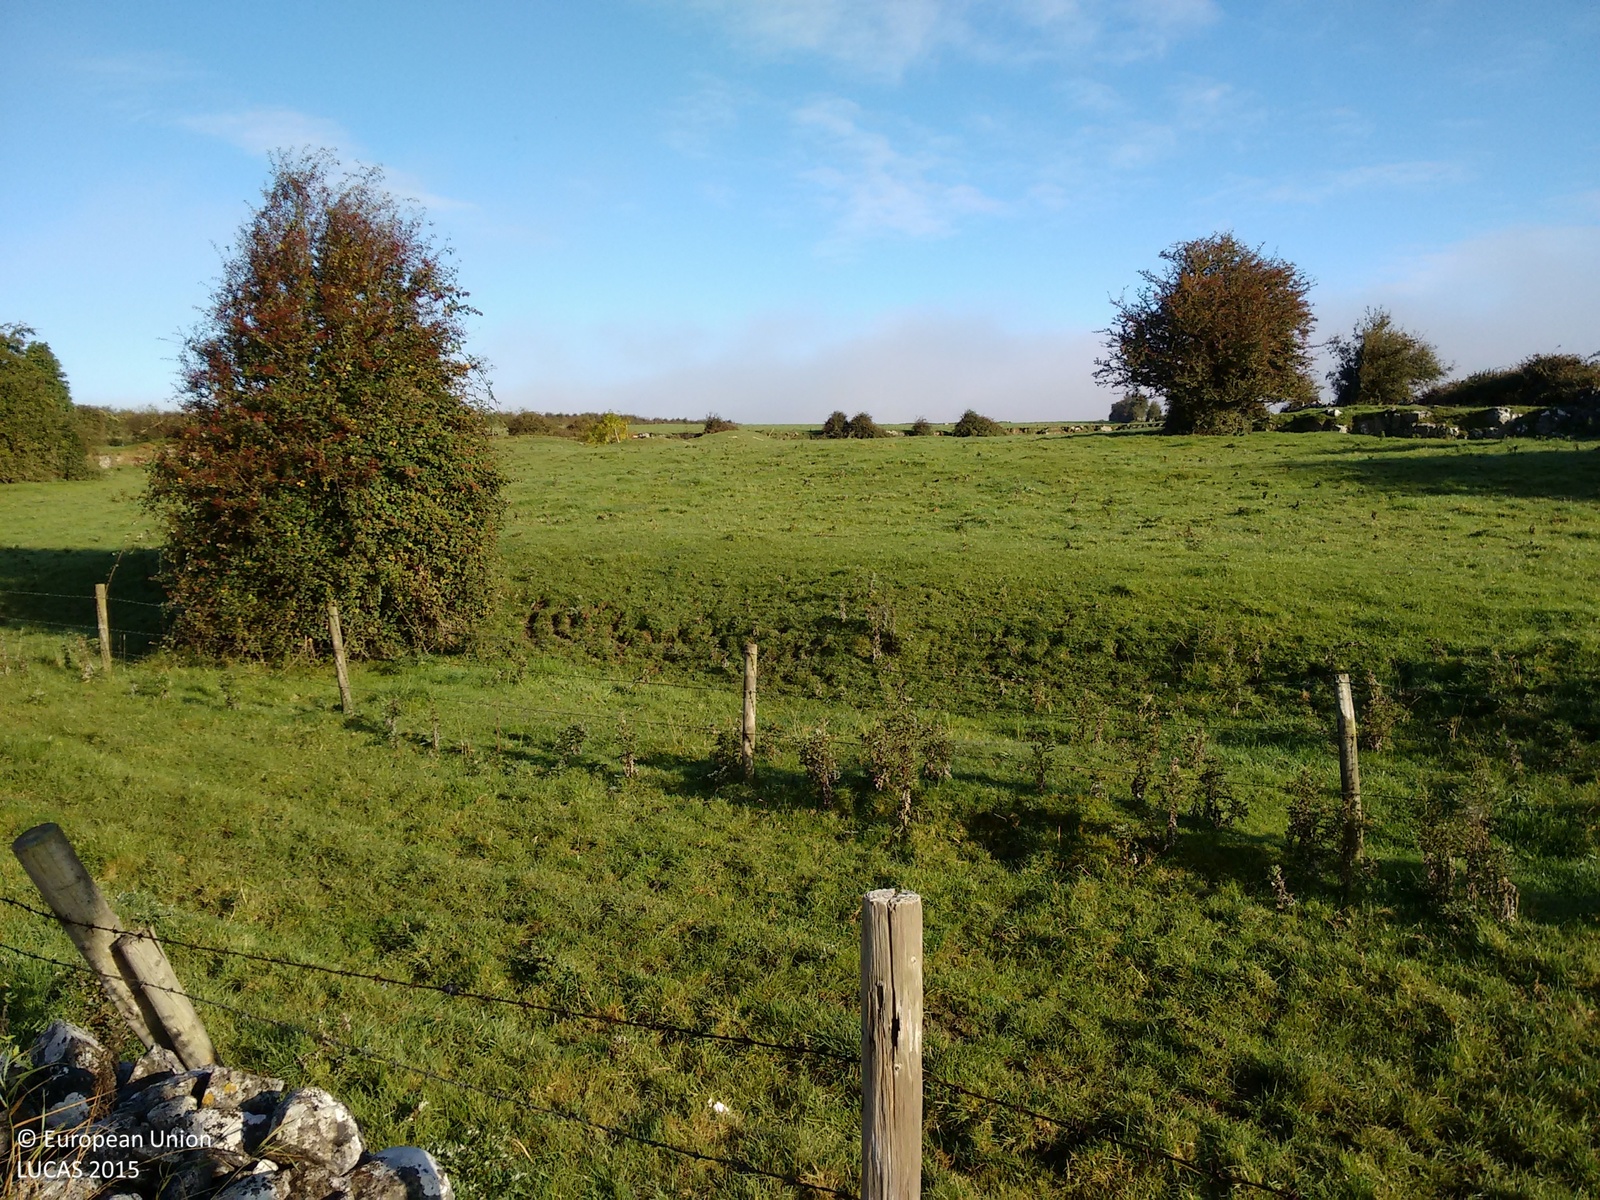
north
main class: Grassland
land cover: Grassland without tree/shrub cover
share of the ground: > 75 %
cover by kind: herbaceous plants 90 %
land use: Agriculture (excluding fallow land and kitchen gardens)
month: October
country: IE
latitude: 53.7743
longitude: -8.2241
